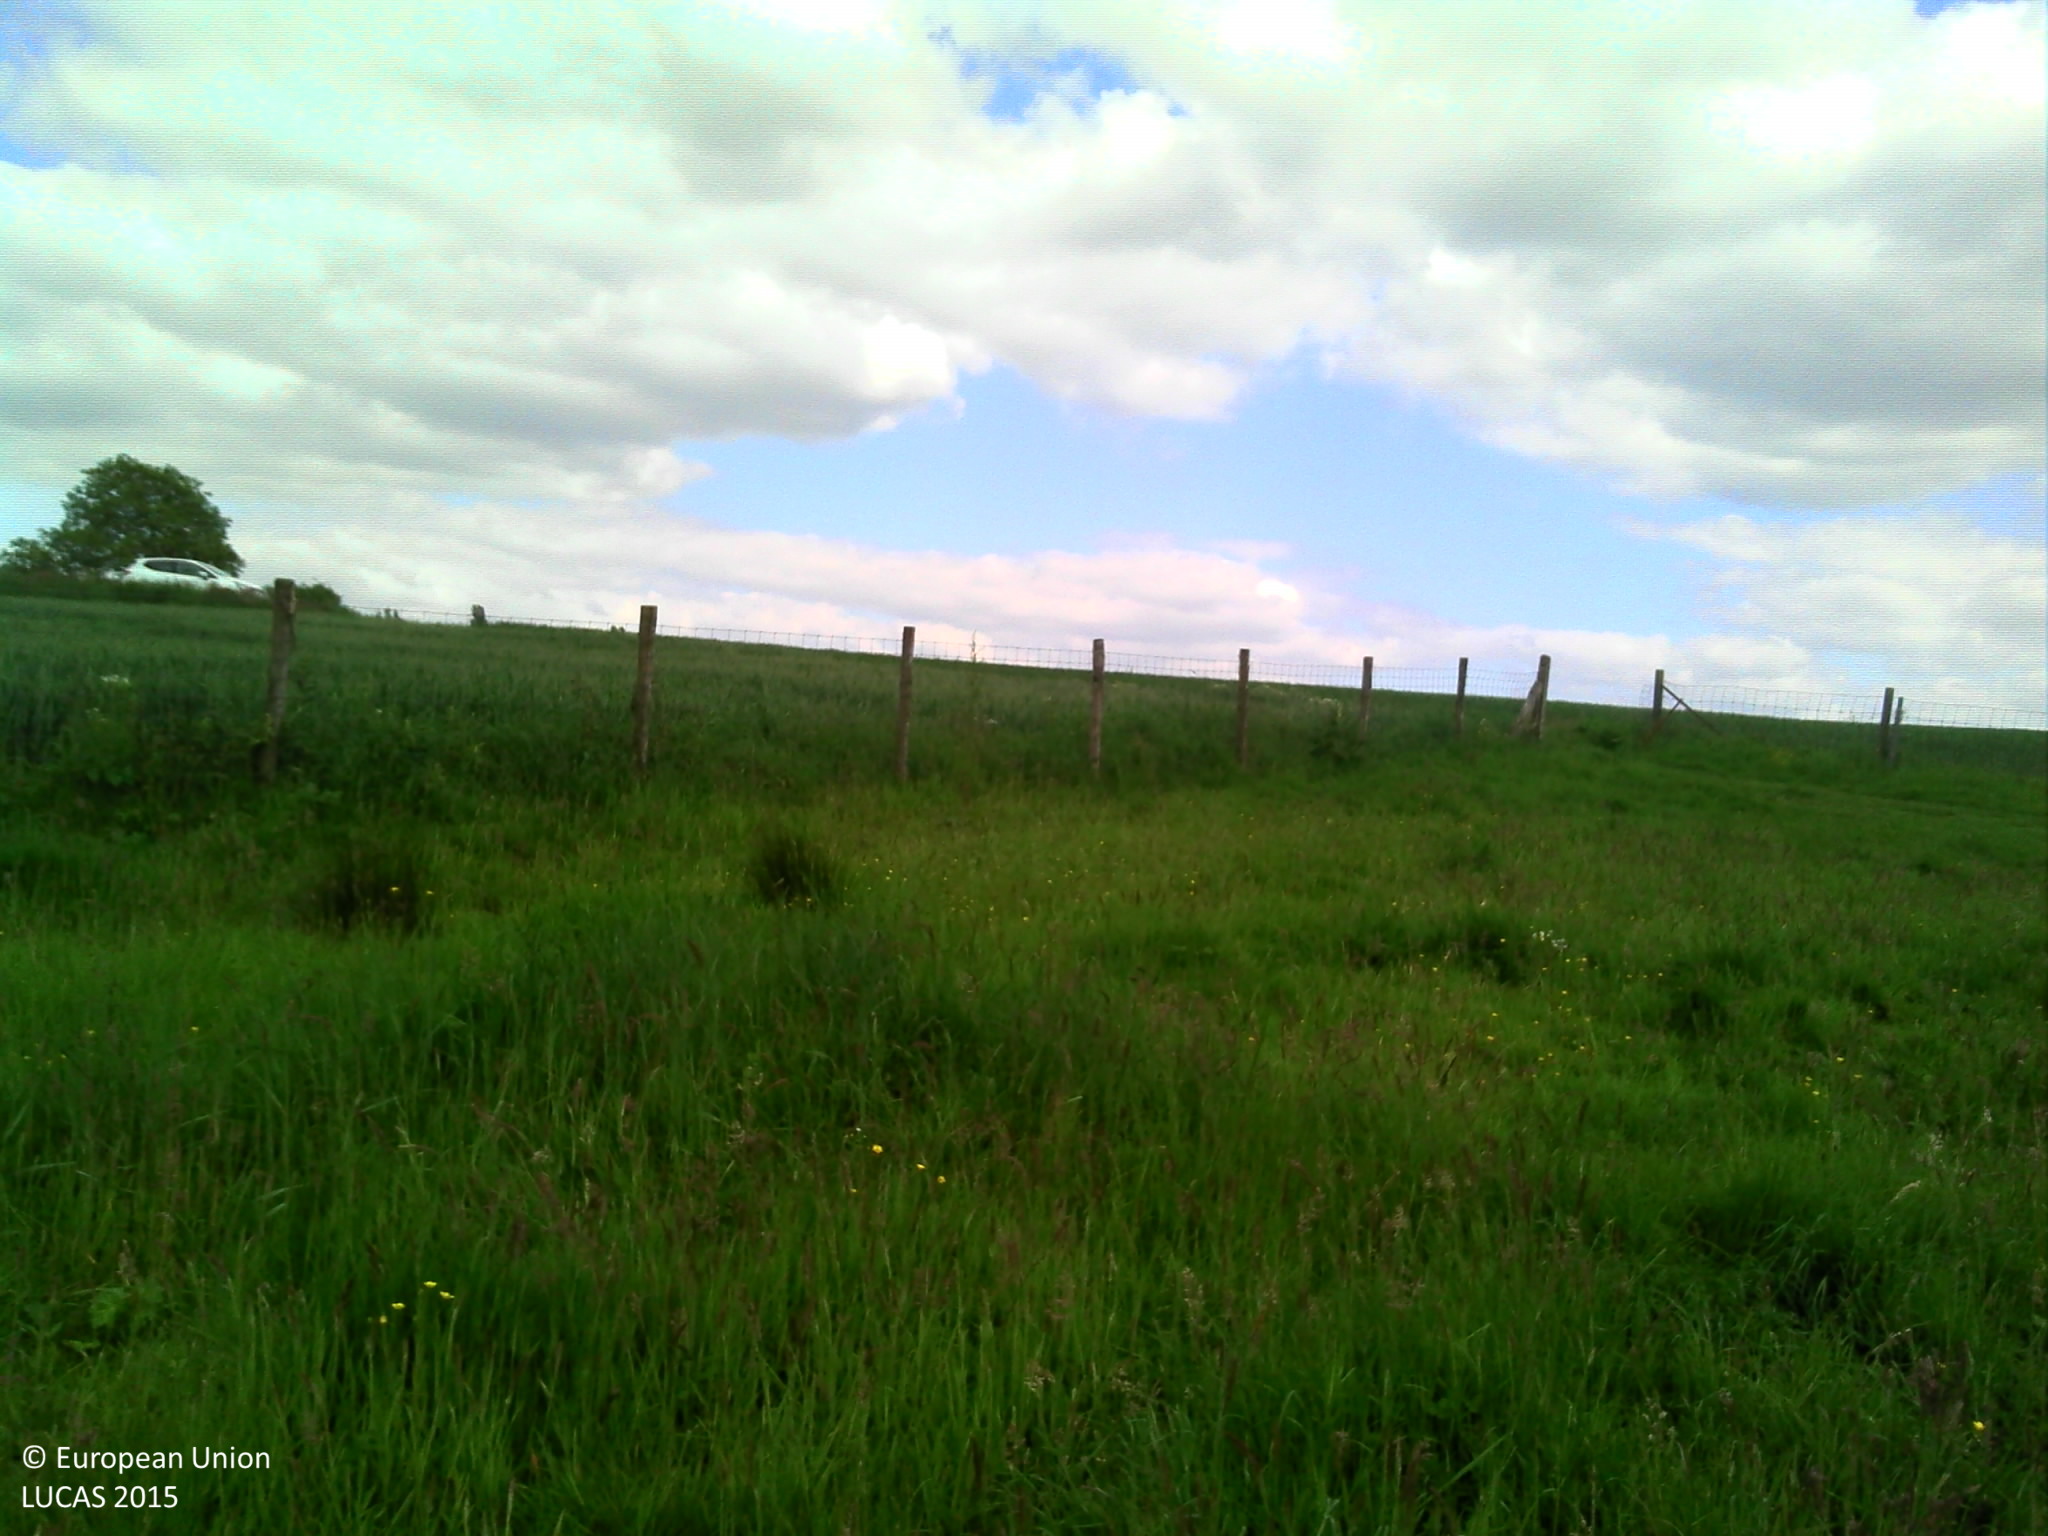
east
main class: Grassland
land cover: Grassland without tree/shrub cover
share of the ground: > 75 %
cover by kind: herbaceous plants 100 %
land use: Agriculture (excluding fallow land and kitchen gardens)
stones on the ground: < 10 %
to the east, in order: Grassland without tree/shrub cover; Fences; Grass margins; Common wheat; Tracks; Common wheat; Maize; Fences; Grassland without tree/shrub cover; Fences; Grassland without tree/shrub cover
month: June
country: BE
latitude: 50.7833
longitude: 3.9945
